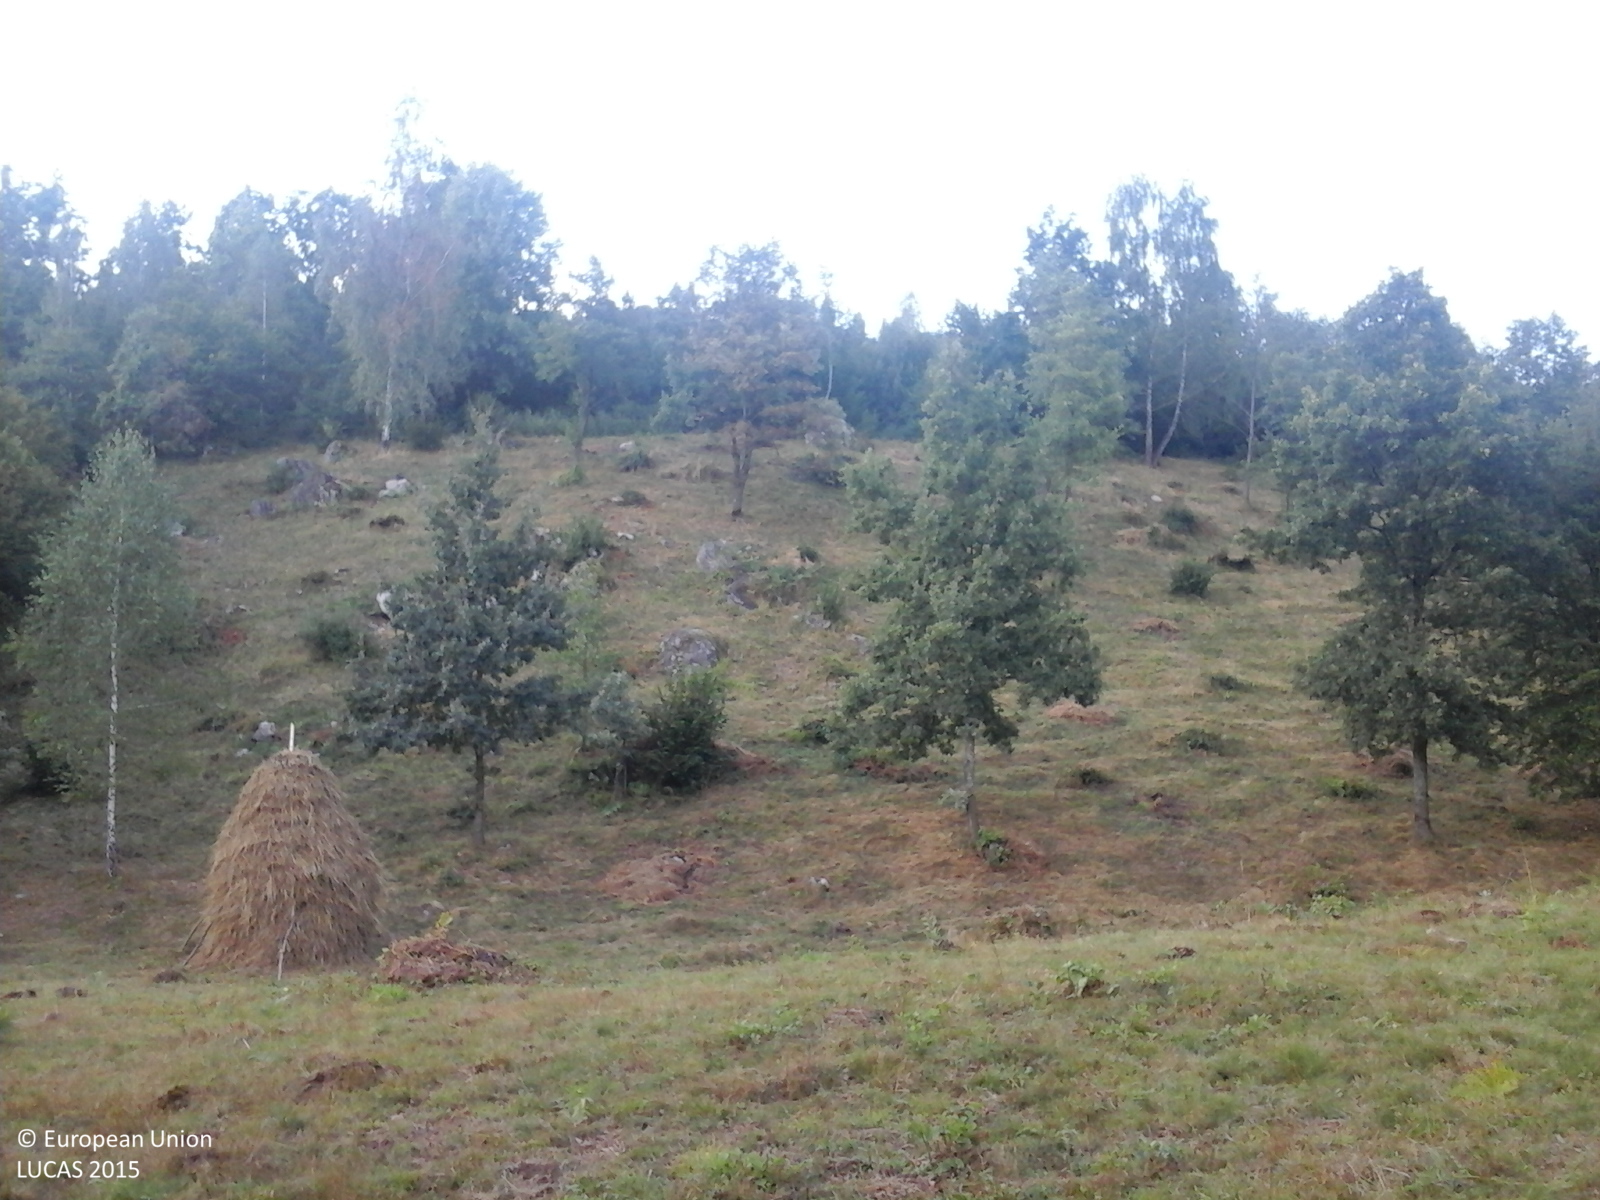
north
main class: Grassland
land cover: Grassland with sparse tree/shrub cover
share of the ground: > 75 %
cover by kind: herbaceous plants 85 %, shrubs 10 %, broadleaved forest trees 5 %
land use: Agriculture (excluding fallow land and kitchen gardens)
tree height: > 5 m
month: September
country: RO
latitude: 47.7831
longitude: 23.8425
